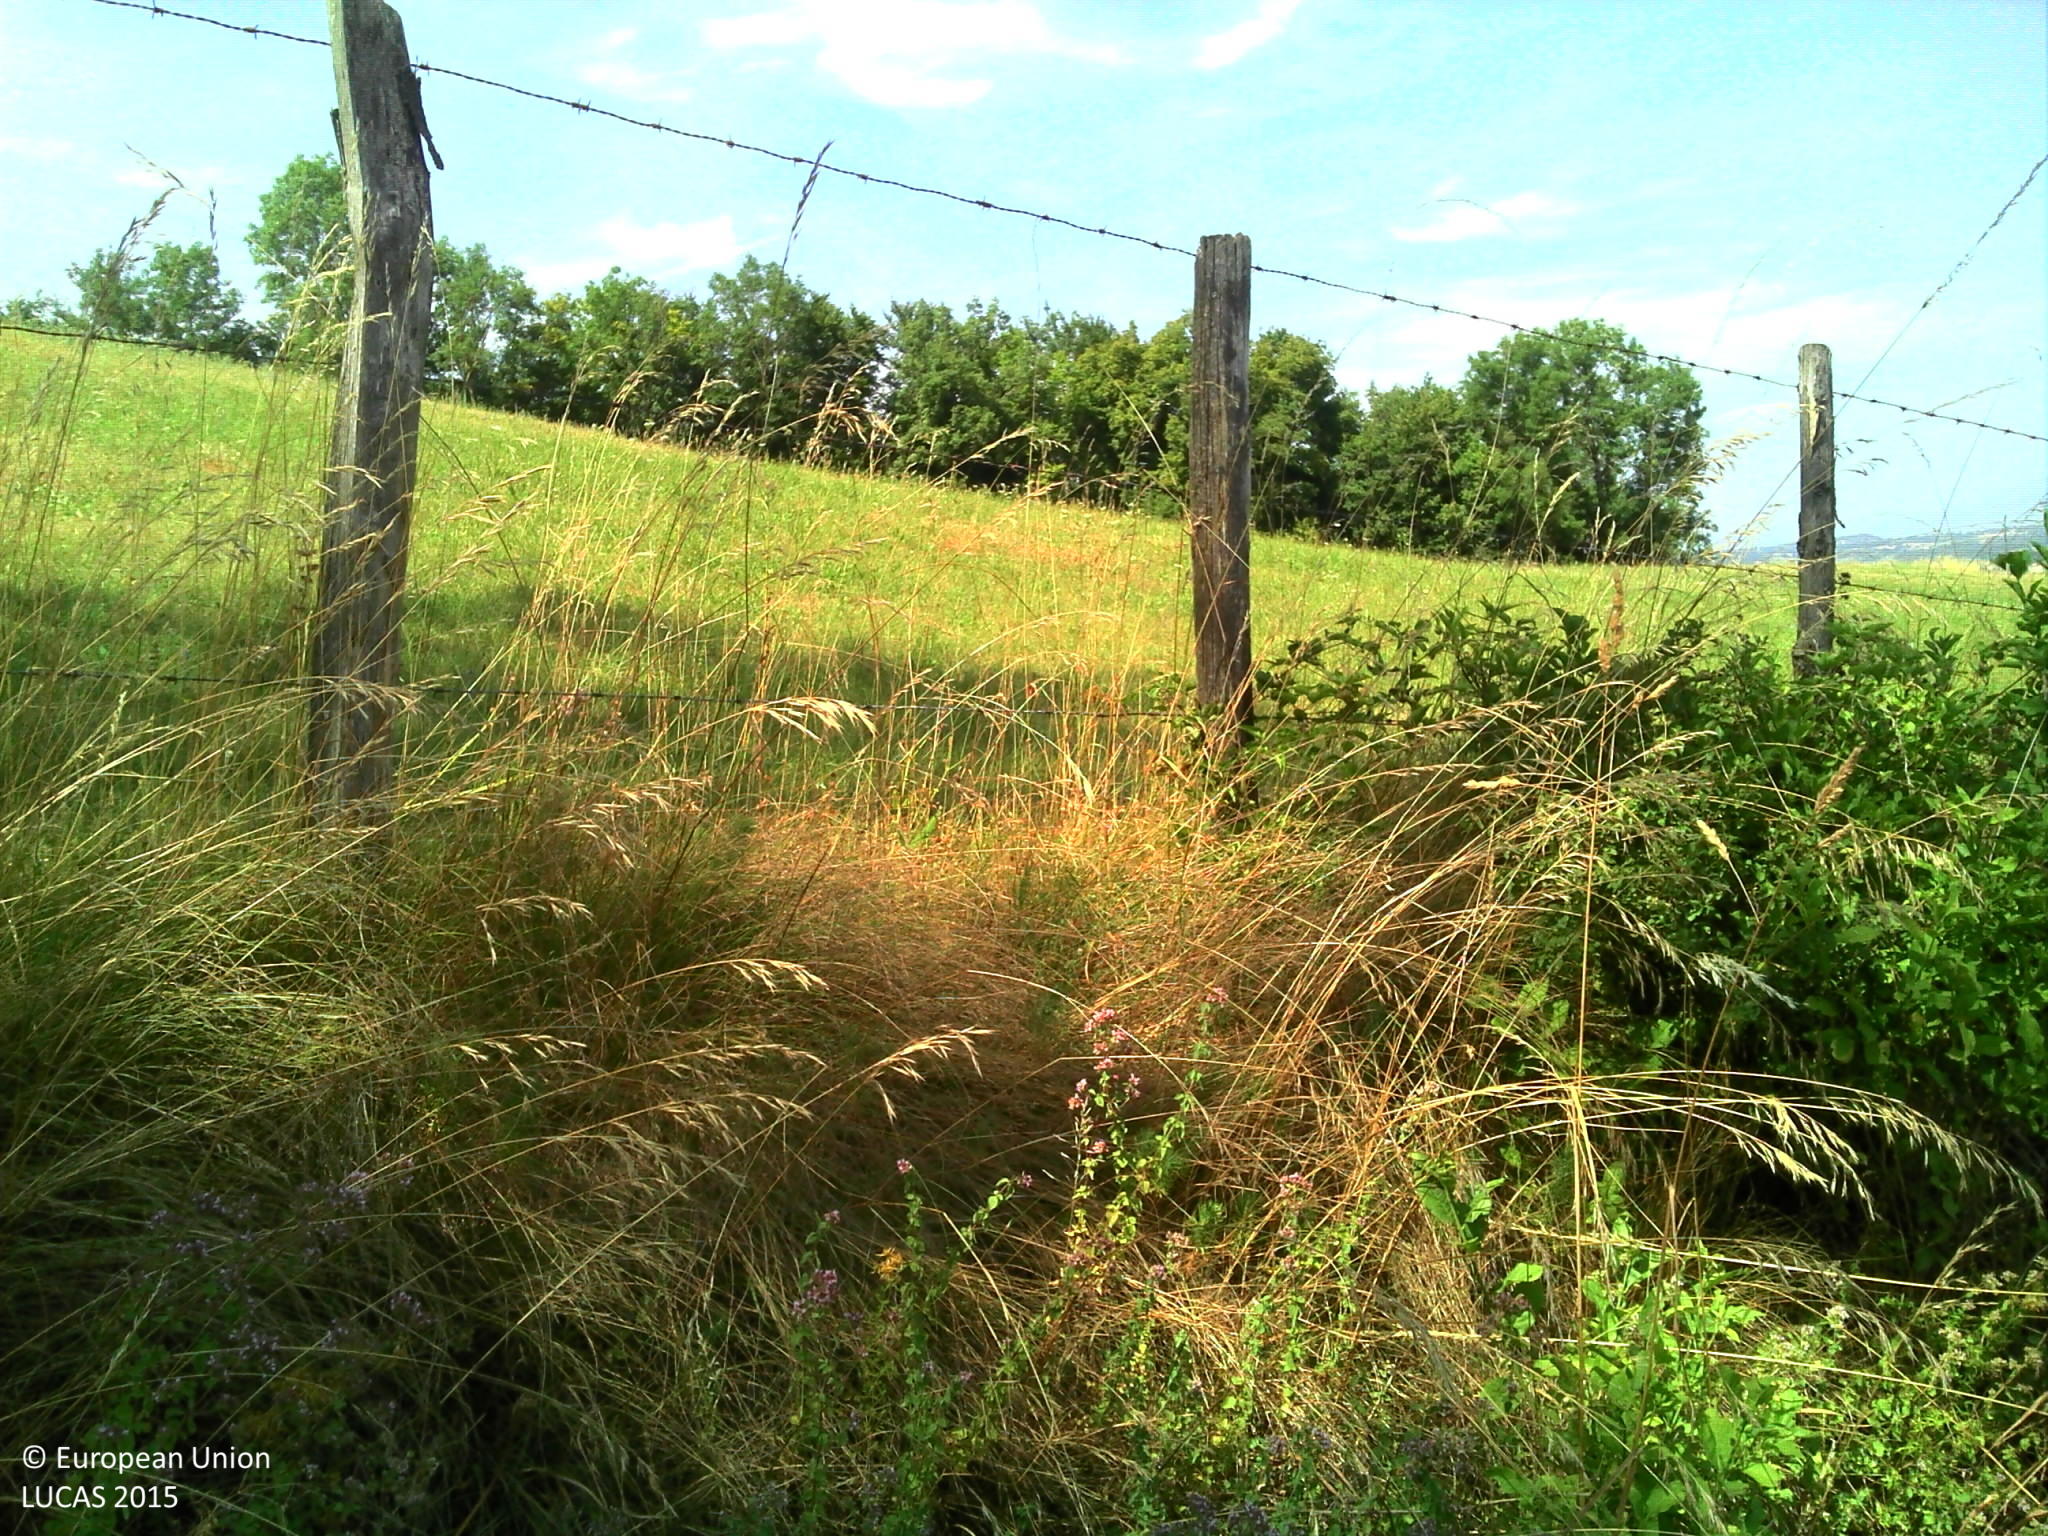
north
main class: Grassland
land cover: Grassland without tree/shrub cover
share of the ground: > 75 %
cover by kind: herbaceous plants 100 %
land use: Agriculture (excluding fallow land and kitchen gardens)
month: July
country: FR
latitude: 45.4600
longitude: 5.4392
